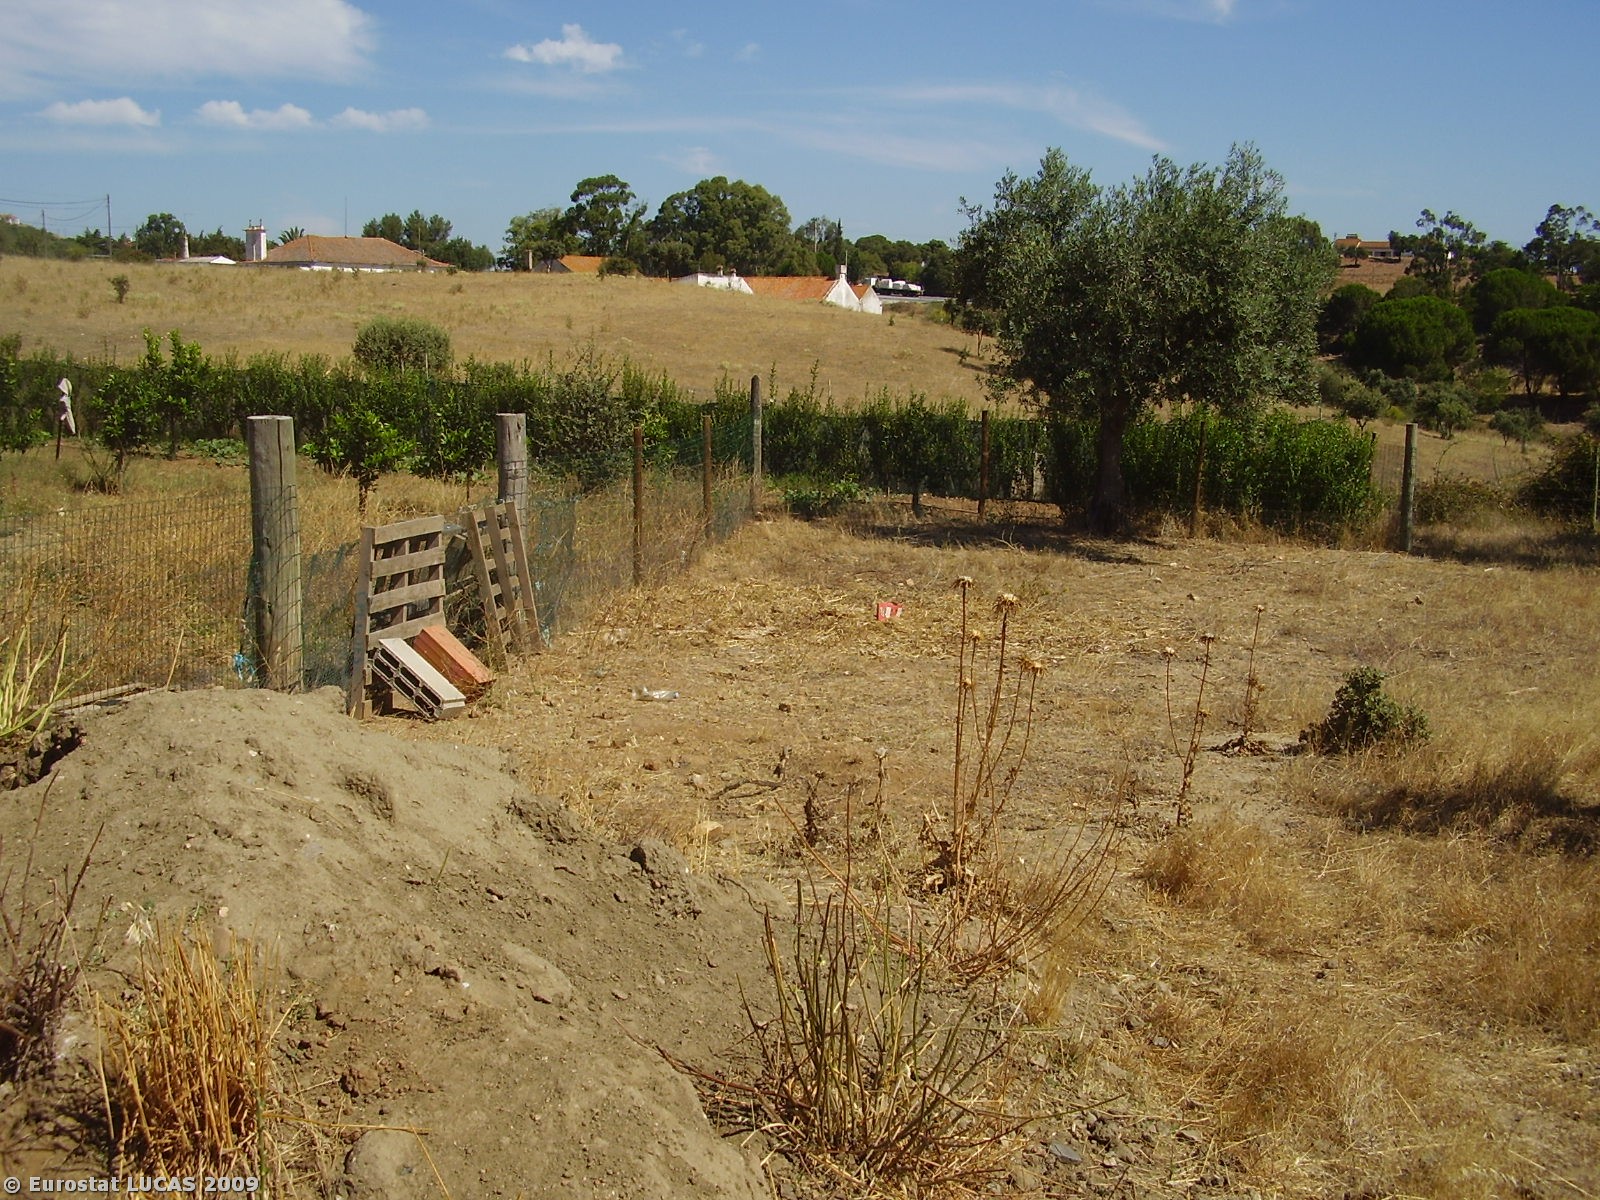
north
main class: Woodland
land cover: Broadleaved woodland
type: broadleaved evergreen forest
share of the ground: 10 - 25 %
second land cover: Grassland with sparse tree/shrub cover
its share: 50 - 75 %
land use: Forestry
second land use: Fallow land
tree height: > 5 m
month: July
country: PT
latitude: 38.7211
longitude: -7.9751
